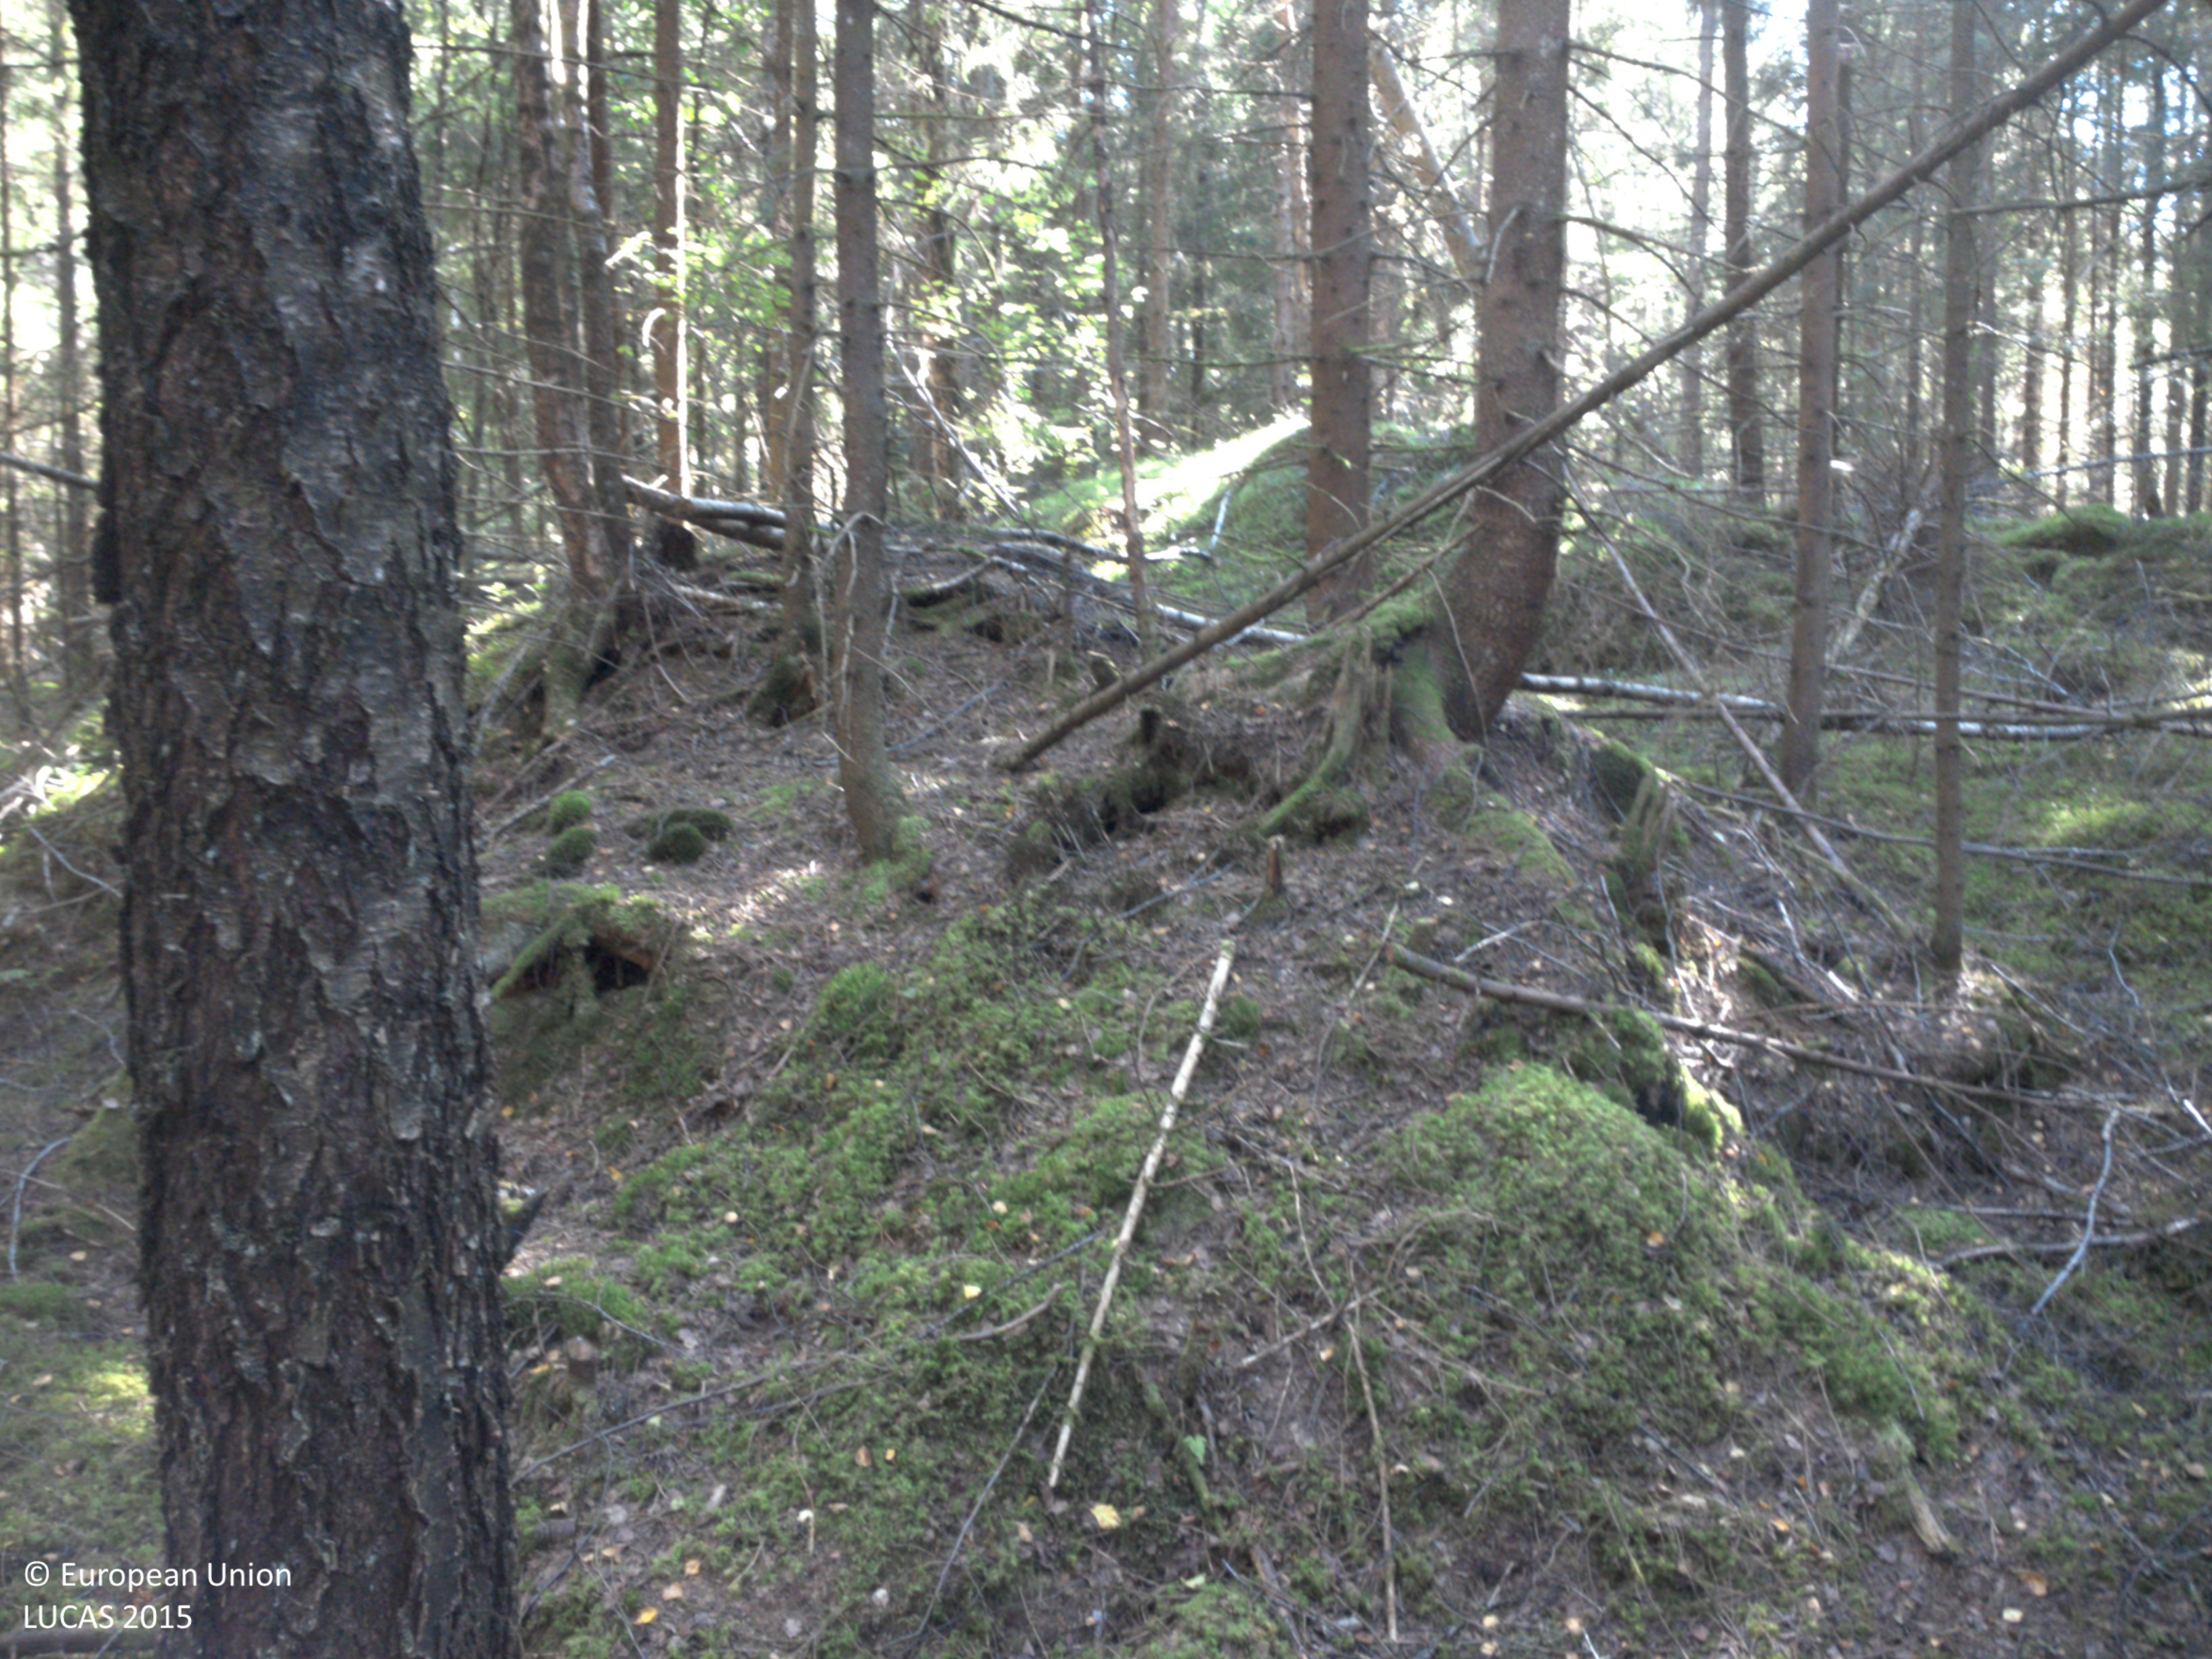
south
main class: Woodland
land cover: Spruce dominated mixed woodland
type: boreal forest
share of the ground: > 75 %
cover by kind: coniferous forest trees 60 %, broadleaved forest trees 20 %, lichens and mosses 20 %
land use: Forestry
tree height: > 5 m
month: August
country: SE
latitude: 58.2191
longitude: 12.2259
